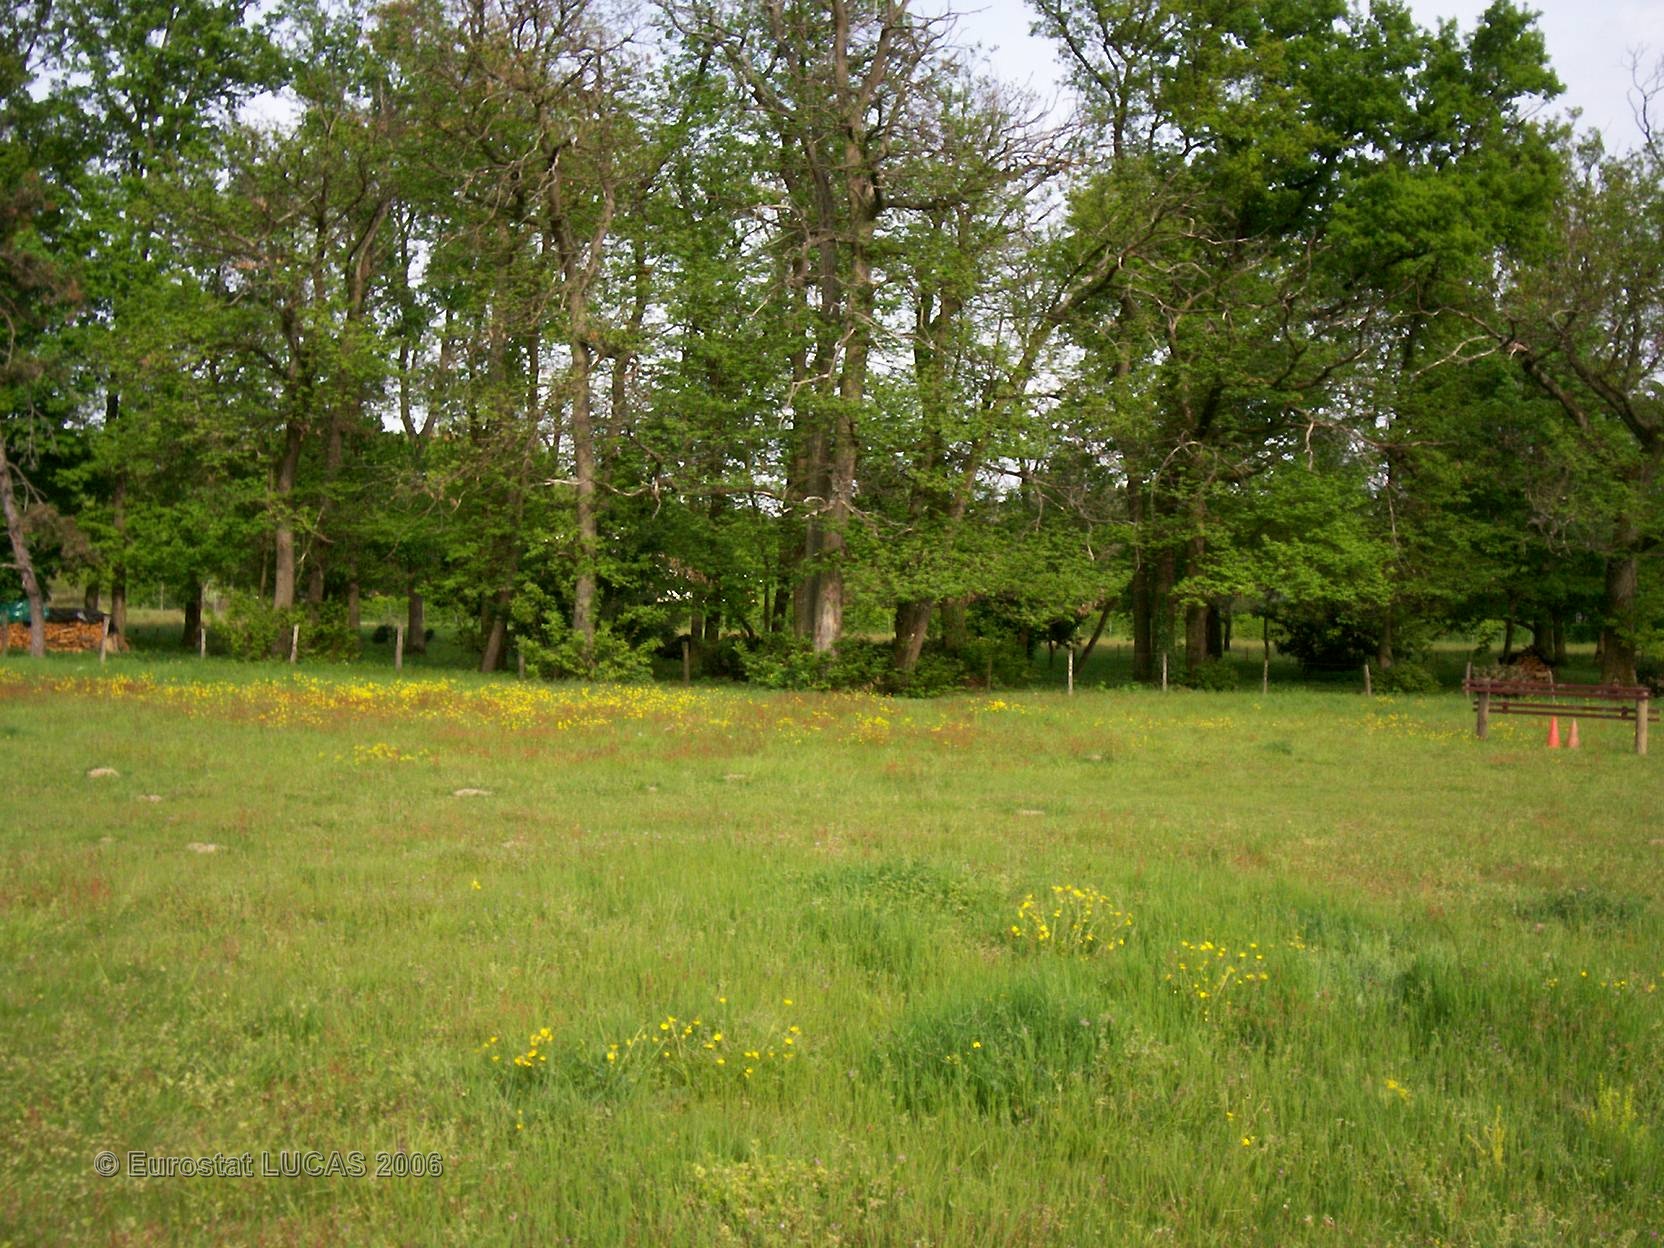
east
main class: Grassland
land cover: Grassland without tree/shrub cover
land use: Agriculture (excluding fallow land and kitchen gardens)
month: May
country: FR
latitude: 45.9362
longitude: 4.8054
